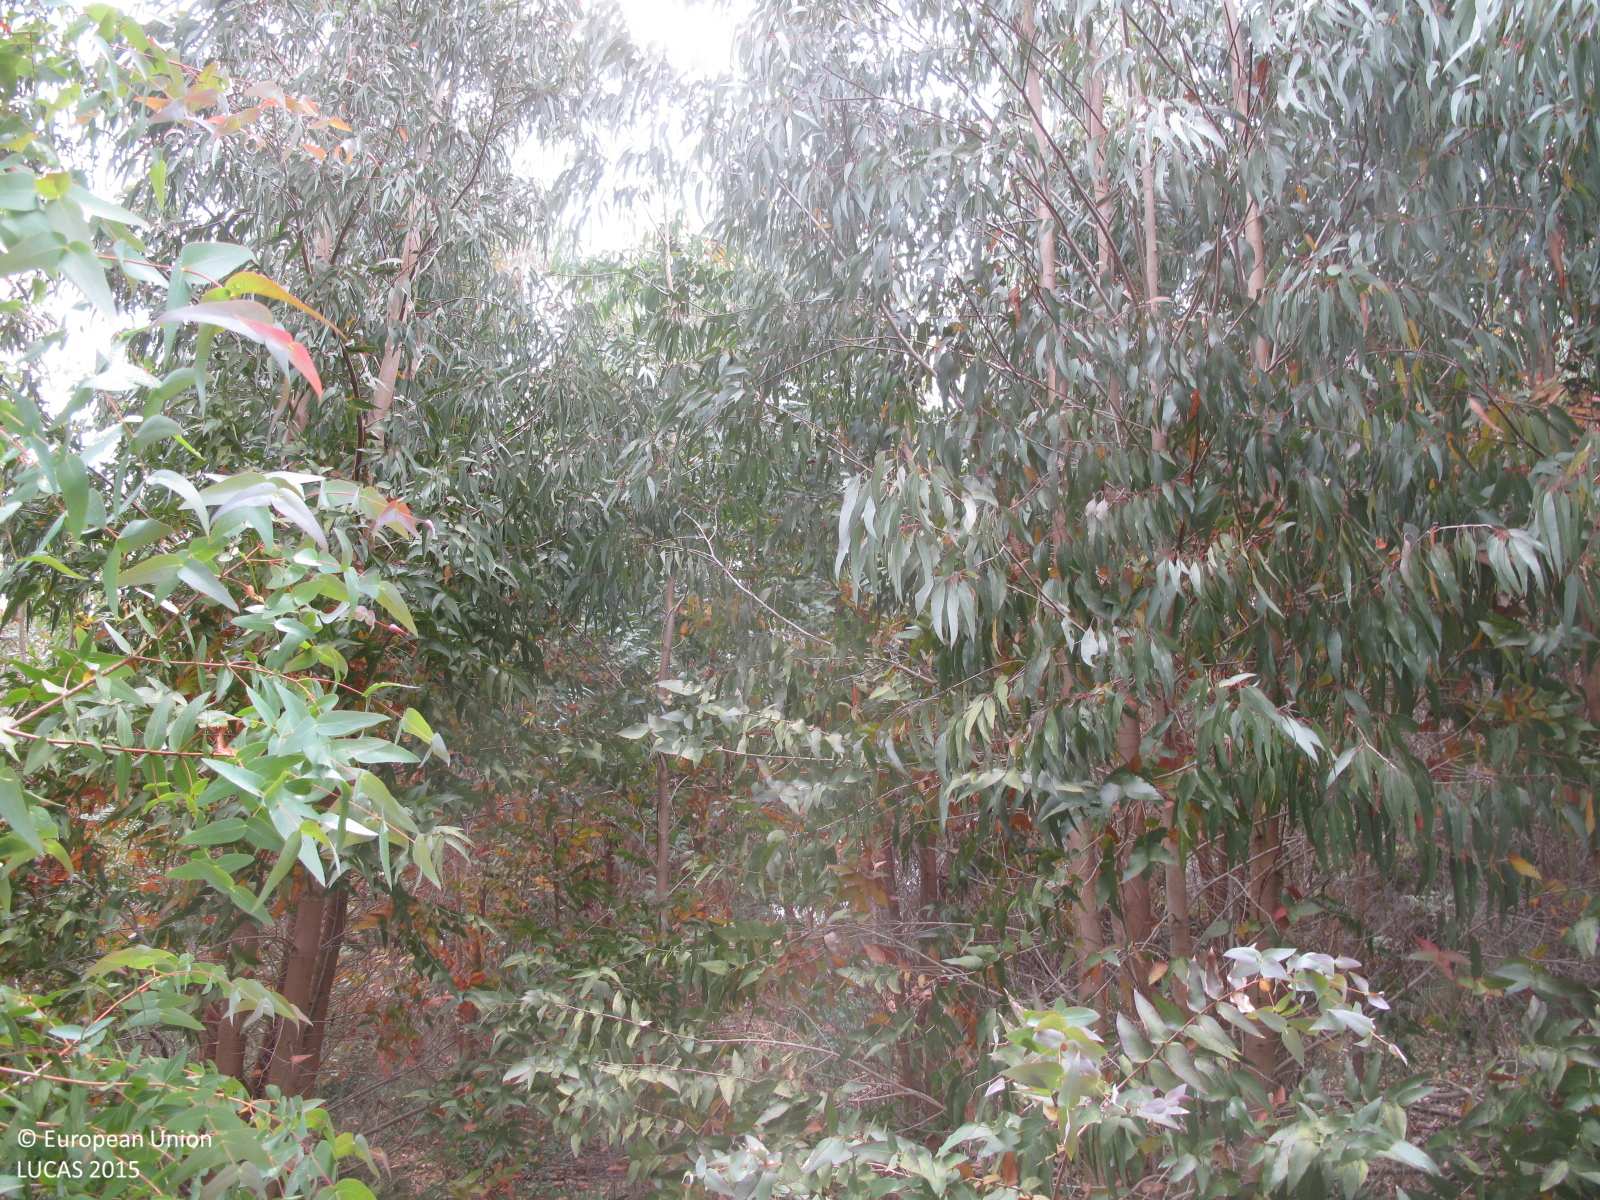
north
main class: Woodland
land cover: Broadleaved woodland
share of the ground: 50 - 75 %
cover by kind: broadleaved forest trees 70 %, shrubs 10 %, herbaceous plants 10 %, unconsolidated bare surface 10 %
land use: Forestry
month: June
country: ES
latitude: 43.1643
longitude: -8.1142
